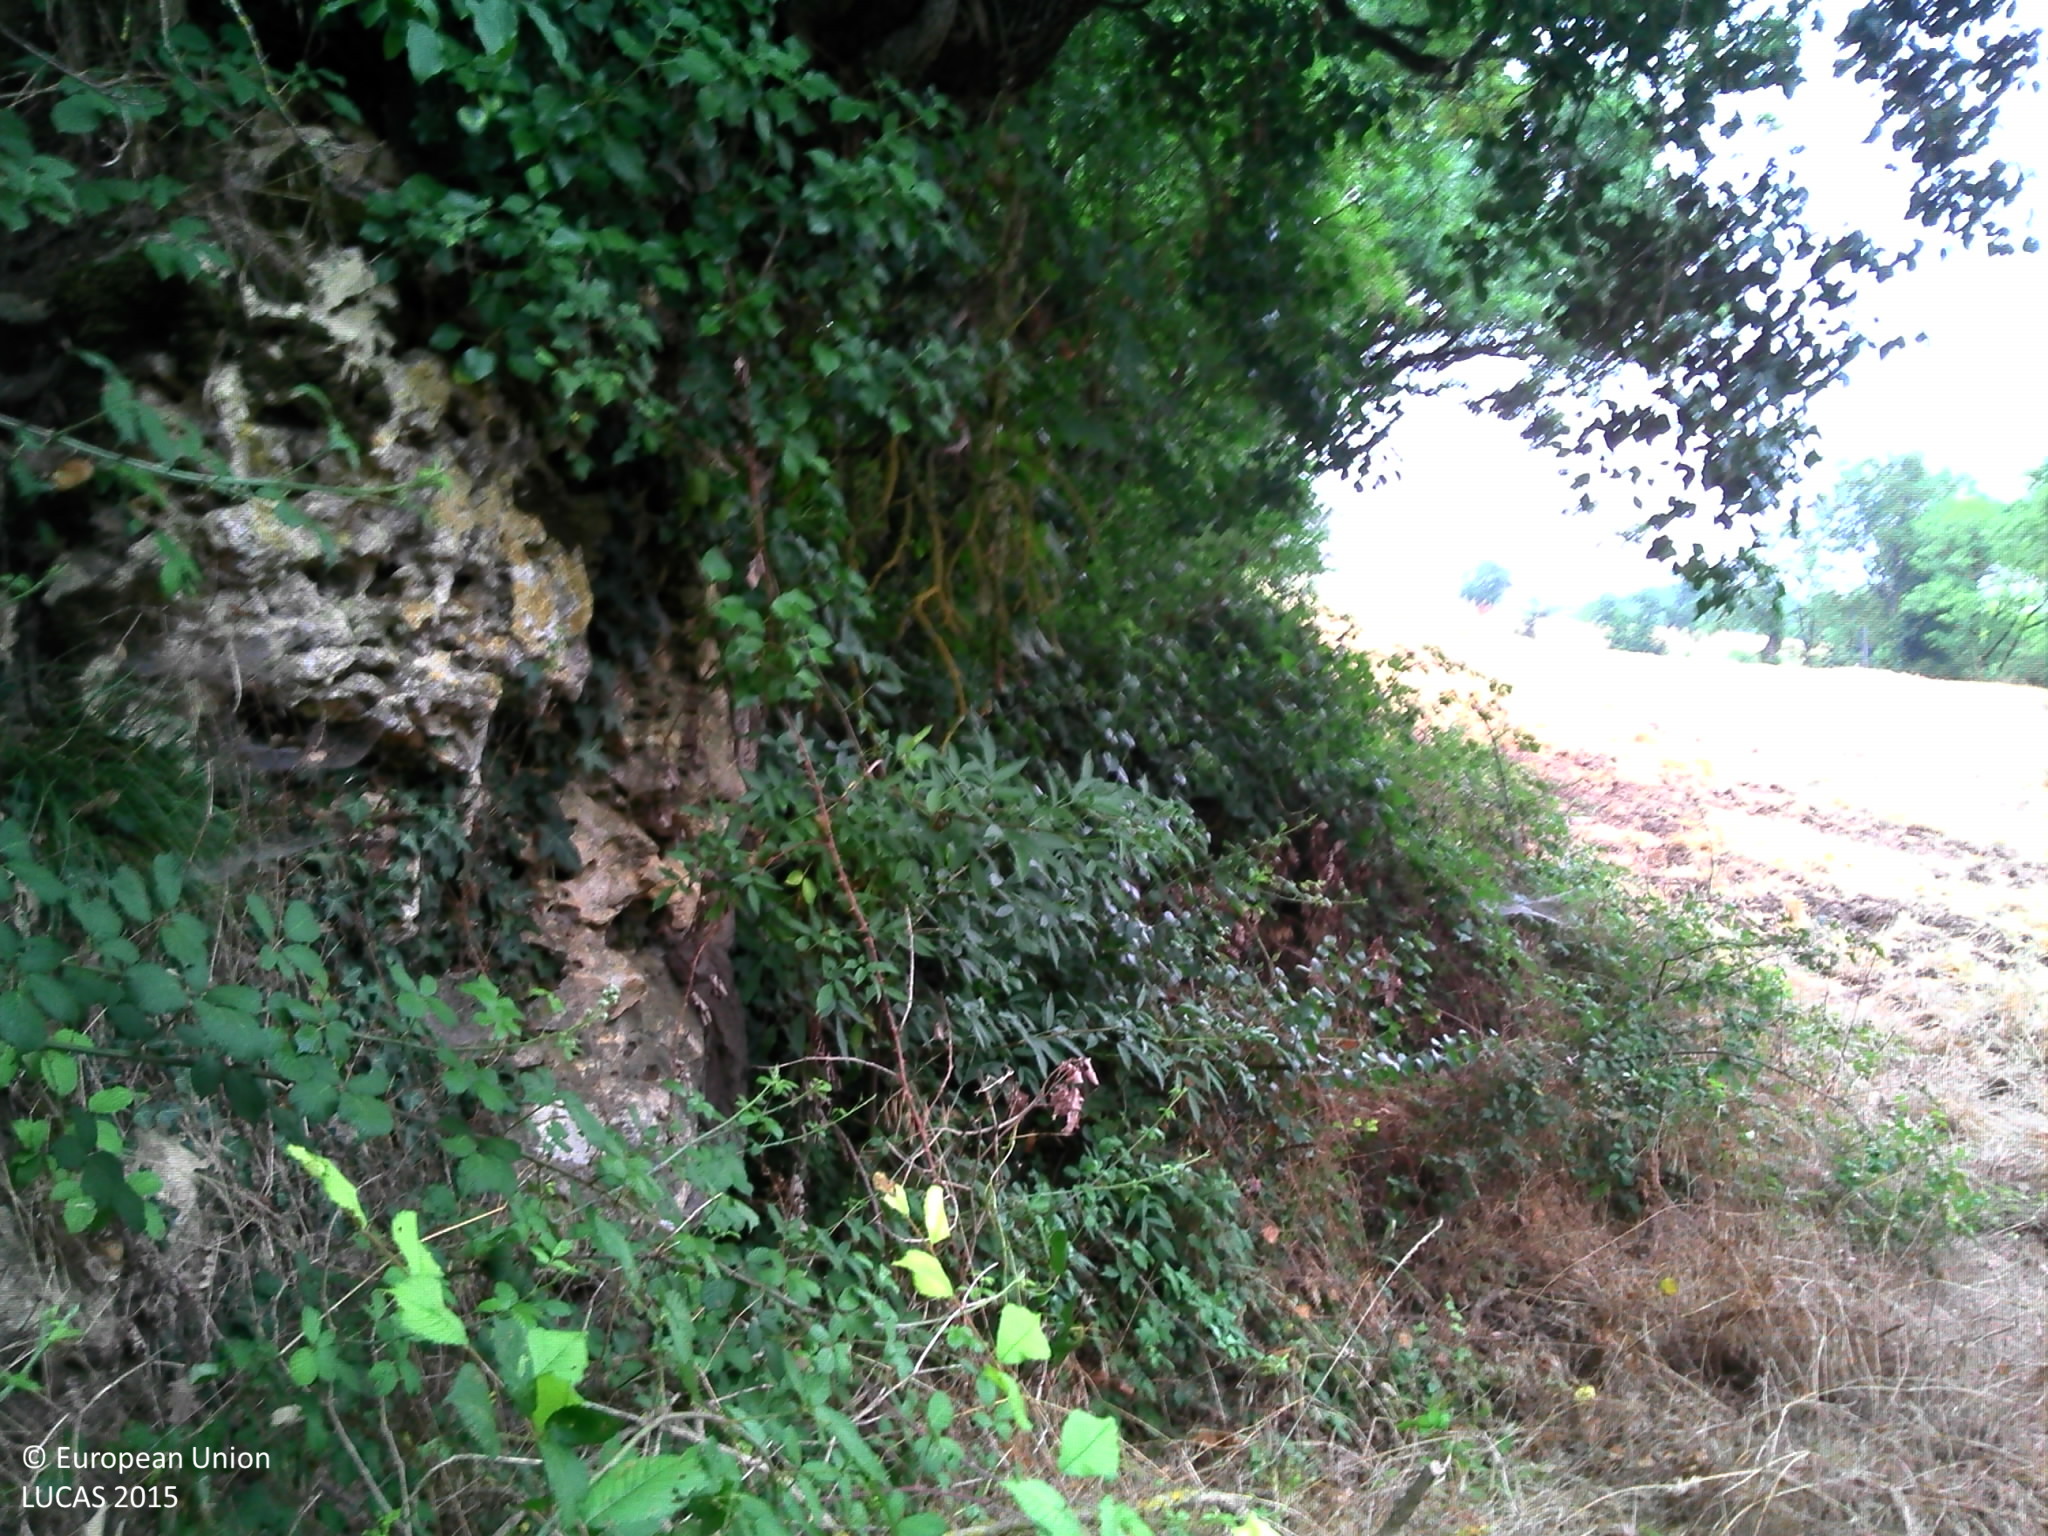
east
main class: Woodland
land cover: Broadleaved woodland
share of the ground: > 75 %
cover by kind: broadleaved forest trees 95 %, shrubs 5 %
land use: Agriculture (excluding fallow land and kitchen gardens)
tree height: > 5 m
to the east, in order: Broadleaved woodland; Other bare soil; Spontaneously vegetated surfaces; Electric lines; Spontaneously vegetated surfaces; Electric lines; Abandoned hedges; Grass margins; Tracks; Barley
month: July
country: FR
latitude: 44.2889
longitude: 0.8348
